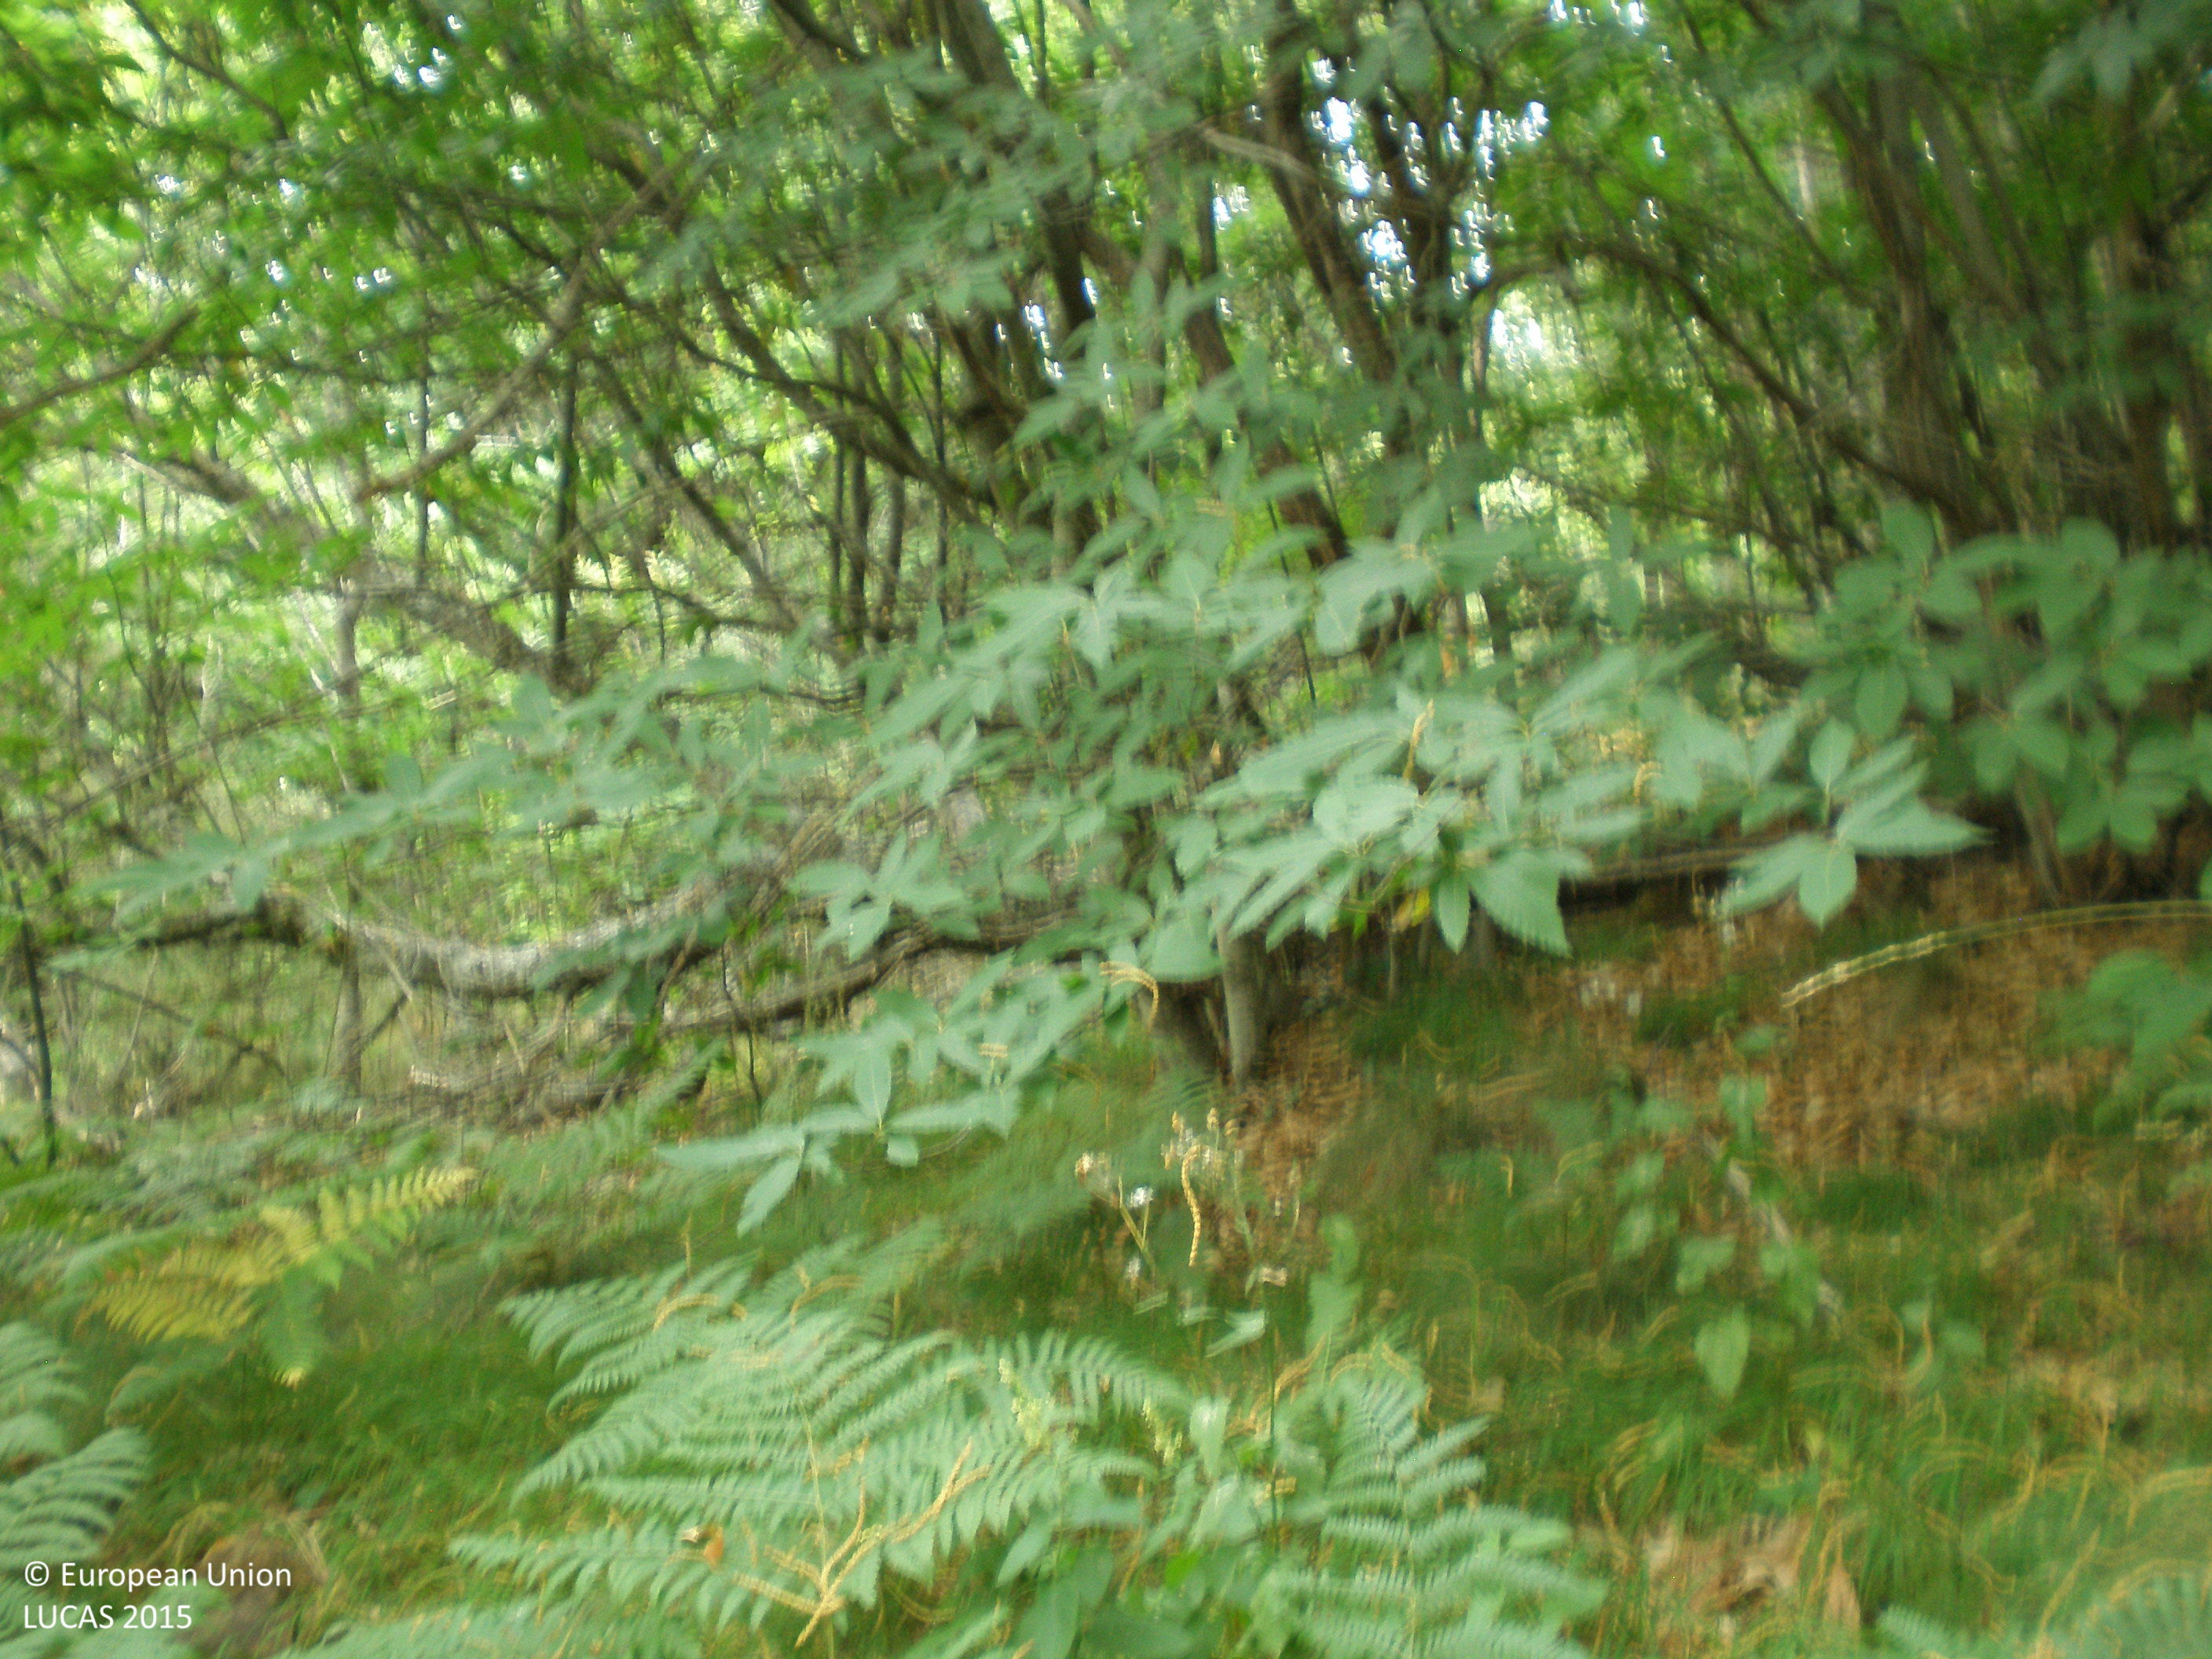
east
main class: Woodland
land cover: Broadleaved woodland
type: thermophilous deciduous forest
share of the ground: > 75 %
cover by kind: broadleaved forest trees 100 %
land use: Forestry
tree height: > 5 m
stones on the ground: < 10 %
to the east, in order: Broadleaved woodland; Dry stone walls; Broadleaved woodland; Dry stone walls; Paved roads, cycling and walking lanes; Broadleaved woodland
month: July
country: ES
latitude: 40.3802
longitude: -5.7719
